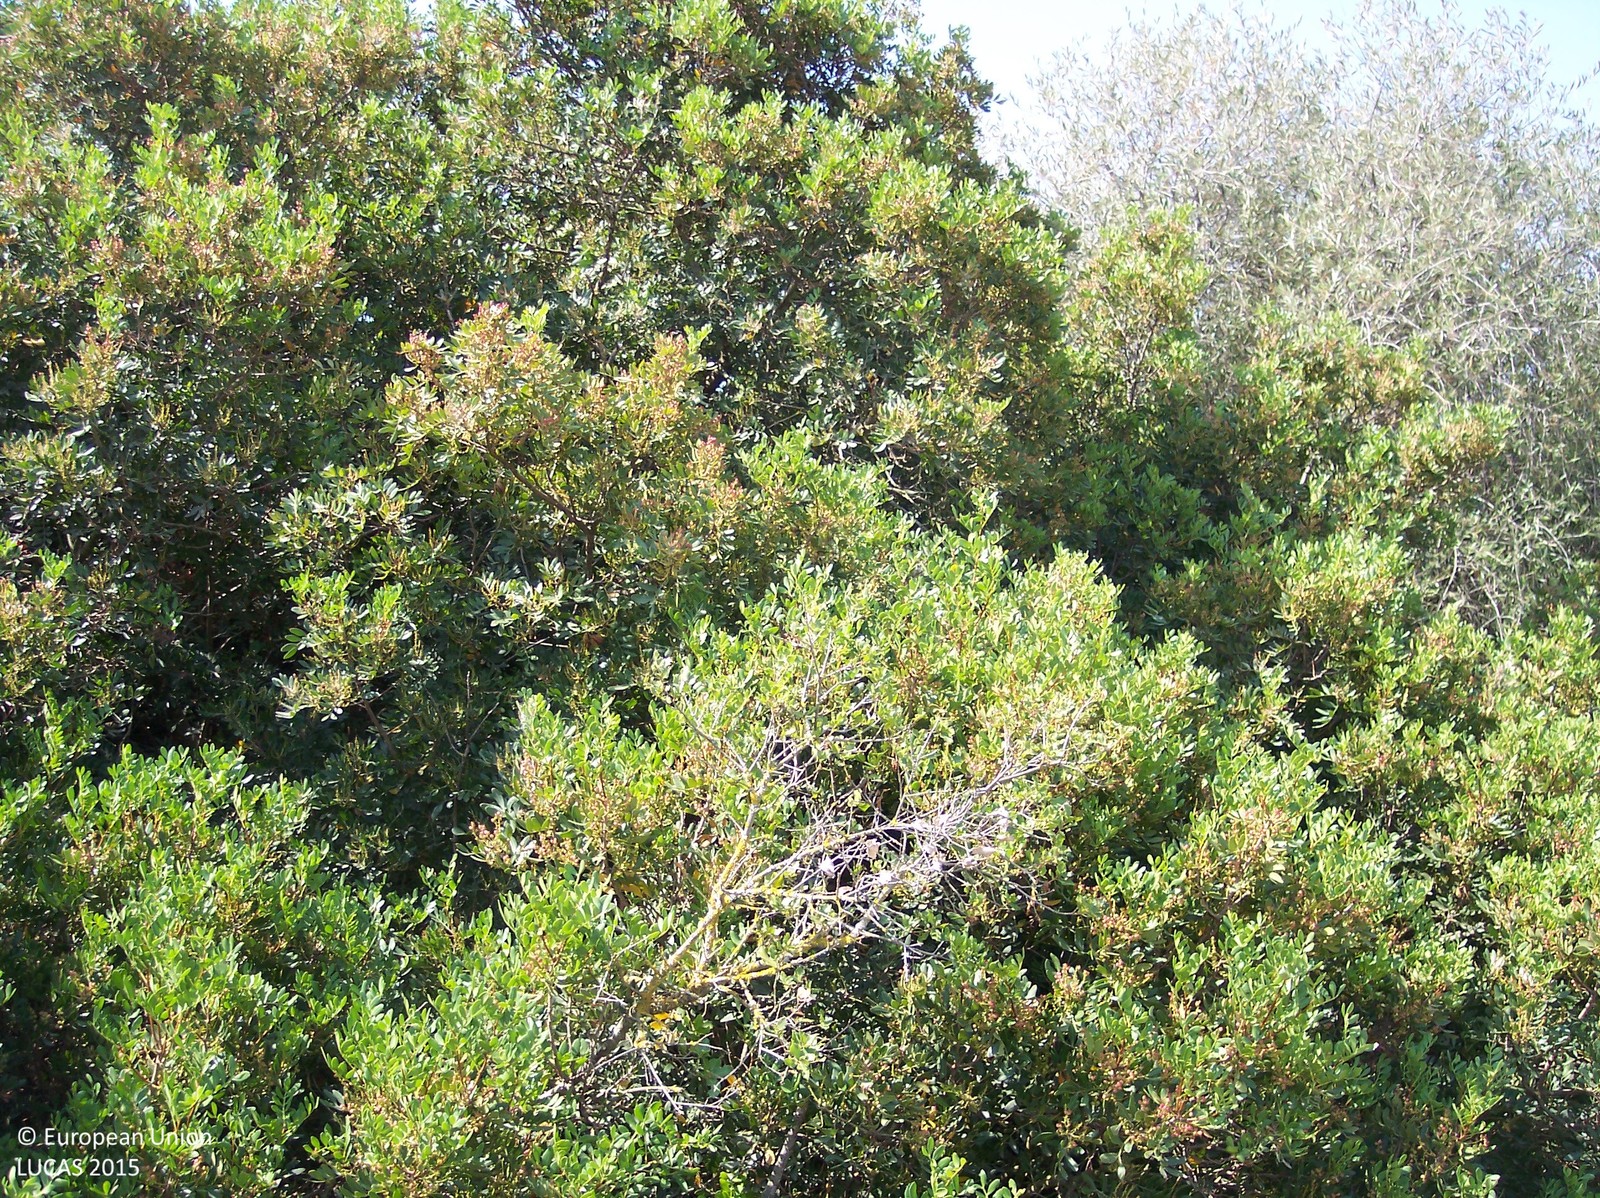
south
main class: Shrubland
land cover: Shrubland without tree cover
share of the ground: > 75 %
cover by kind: shrubs 90 %, herbaceous plants 5 %, unconsolidated bare surface 5 %
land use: Semi-natural and natural areas not in use
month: July
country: ES
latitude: 36.9893
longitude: -5.7987
